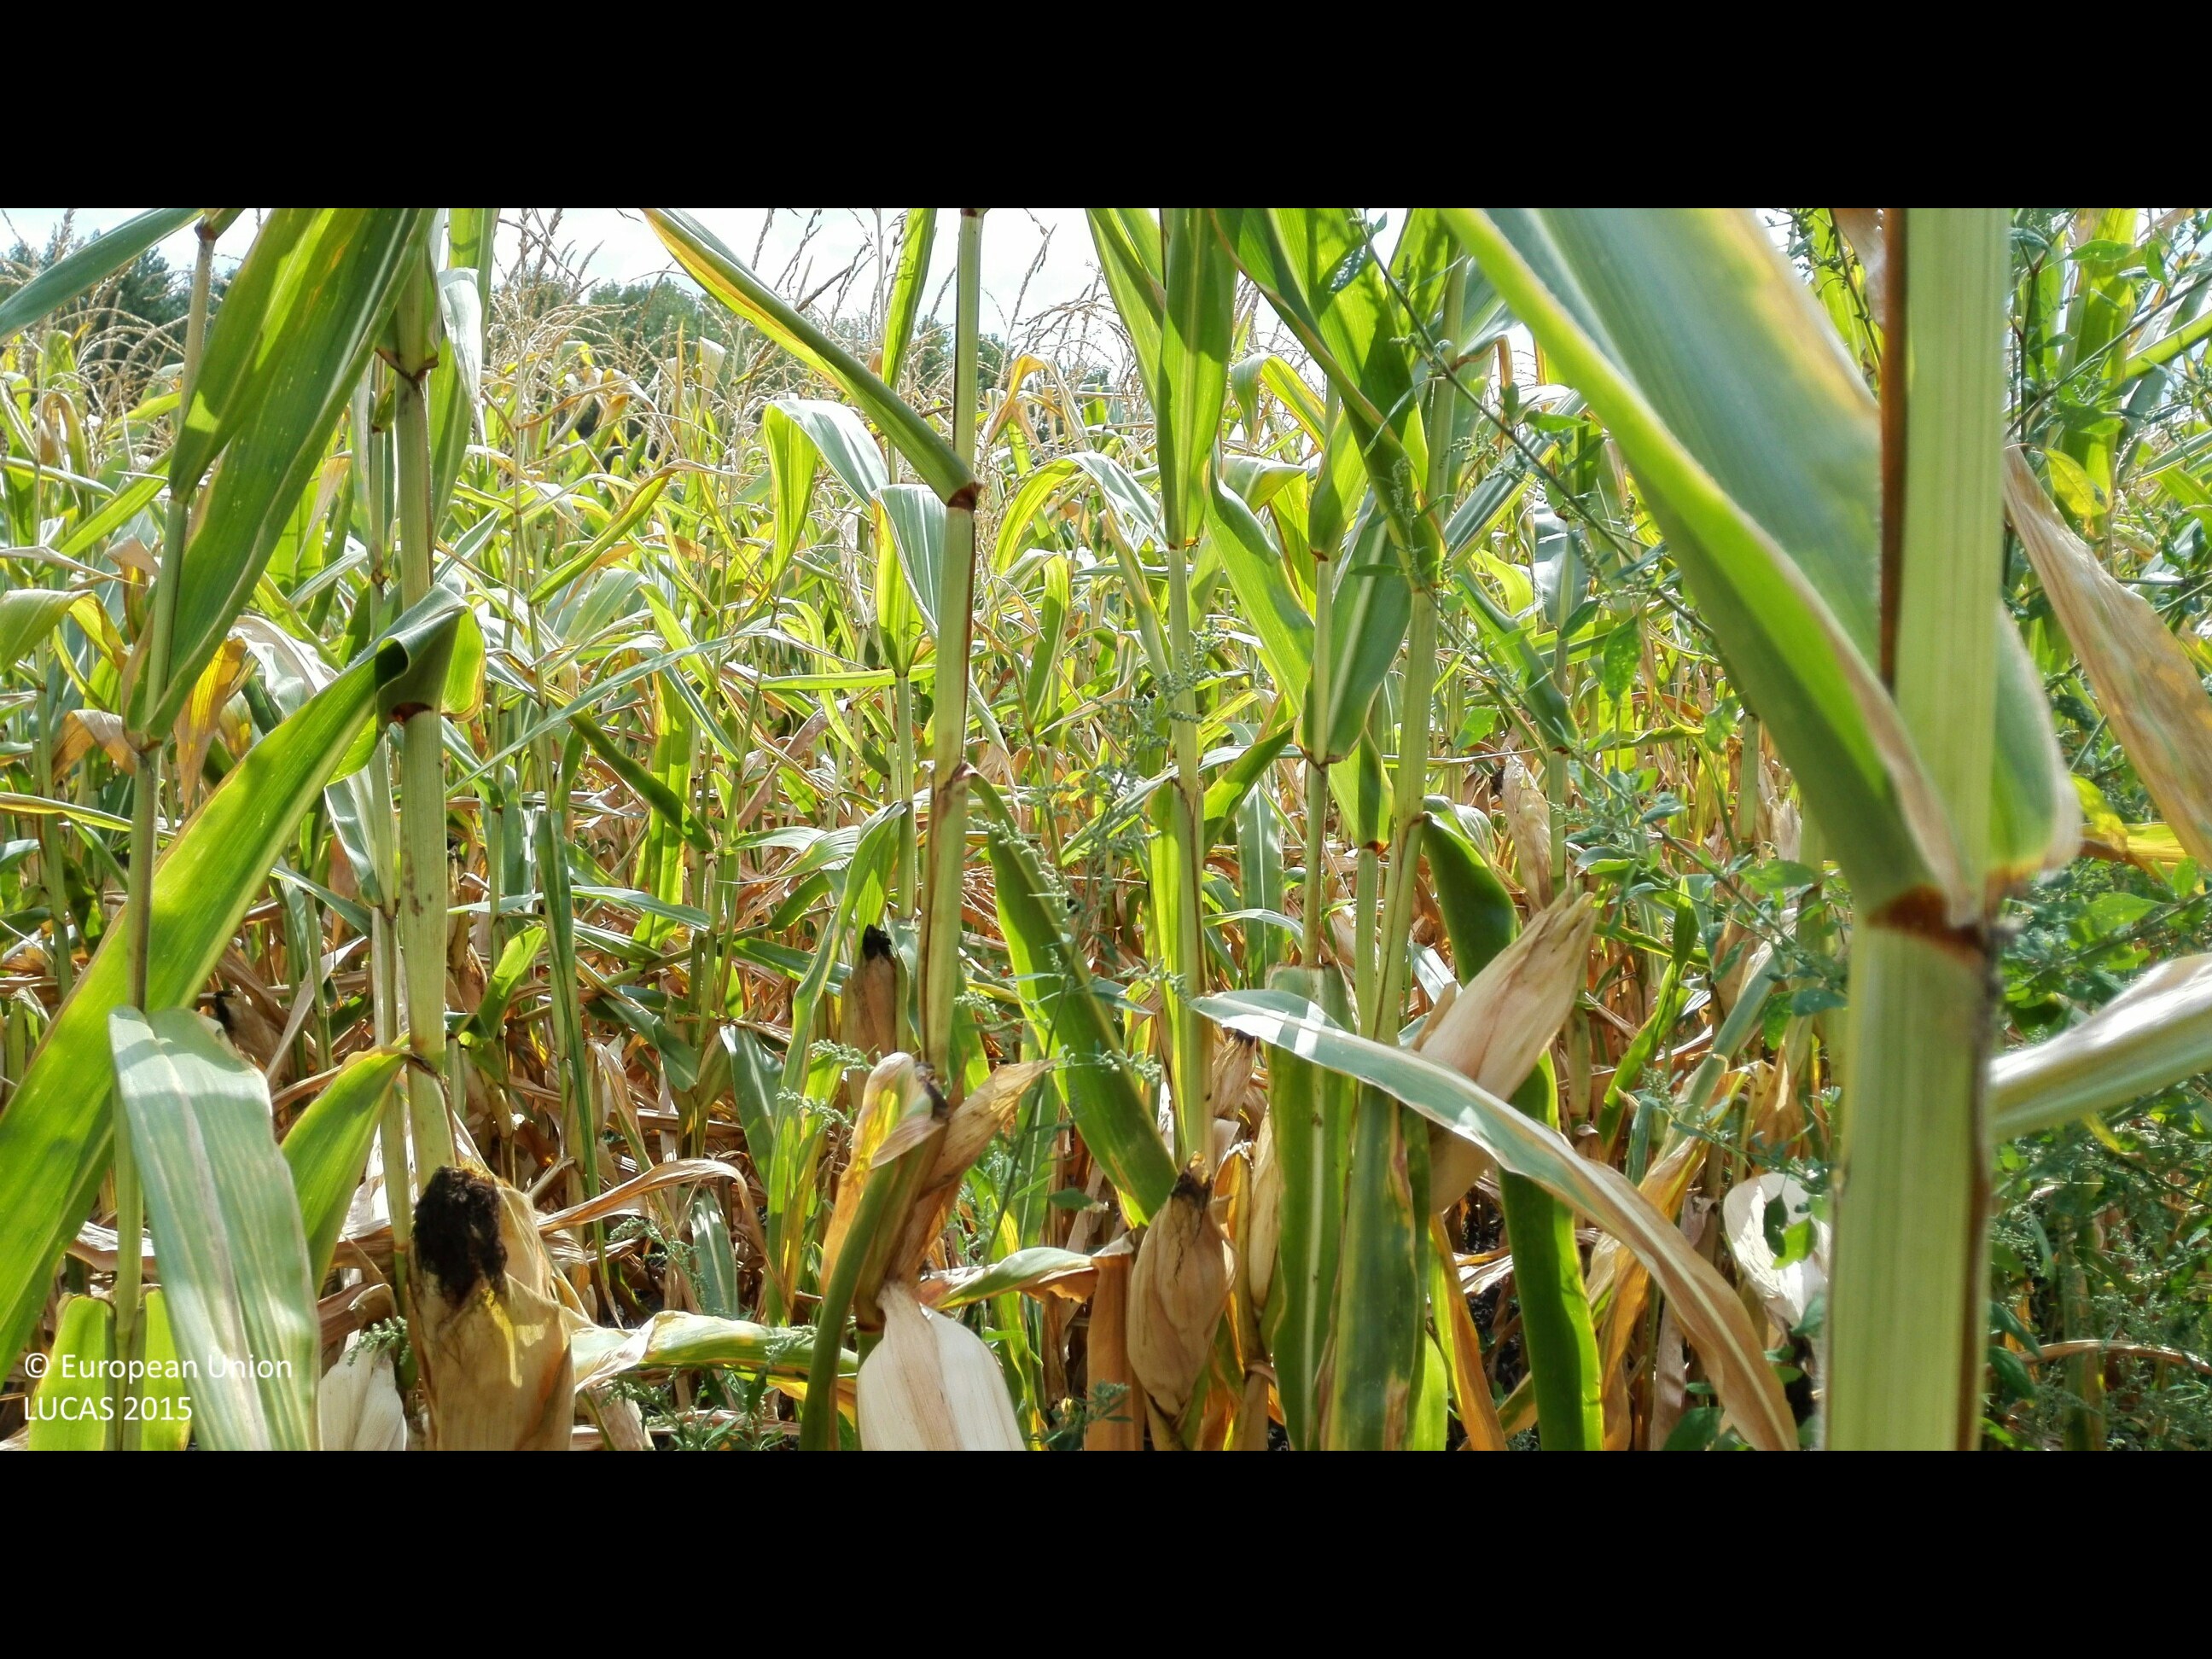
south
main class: Cropland
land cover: Maize
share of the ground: > 75 %
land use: Agriculture (excluding fallow land and kitchen gardens)
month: August
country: HU
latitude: 47.3692
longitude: 21.6310
